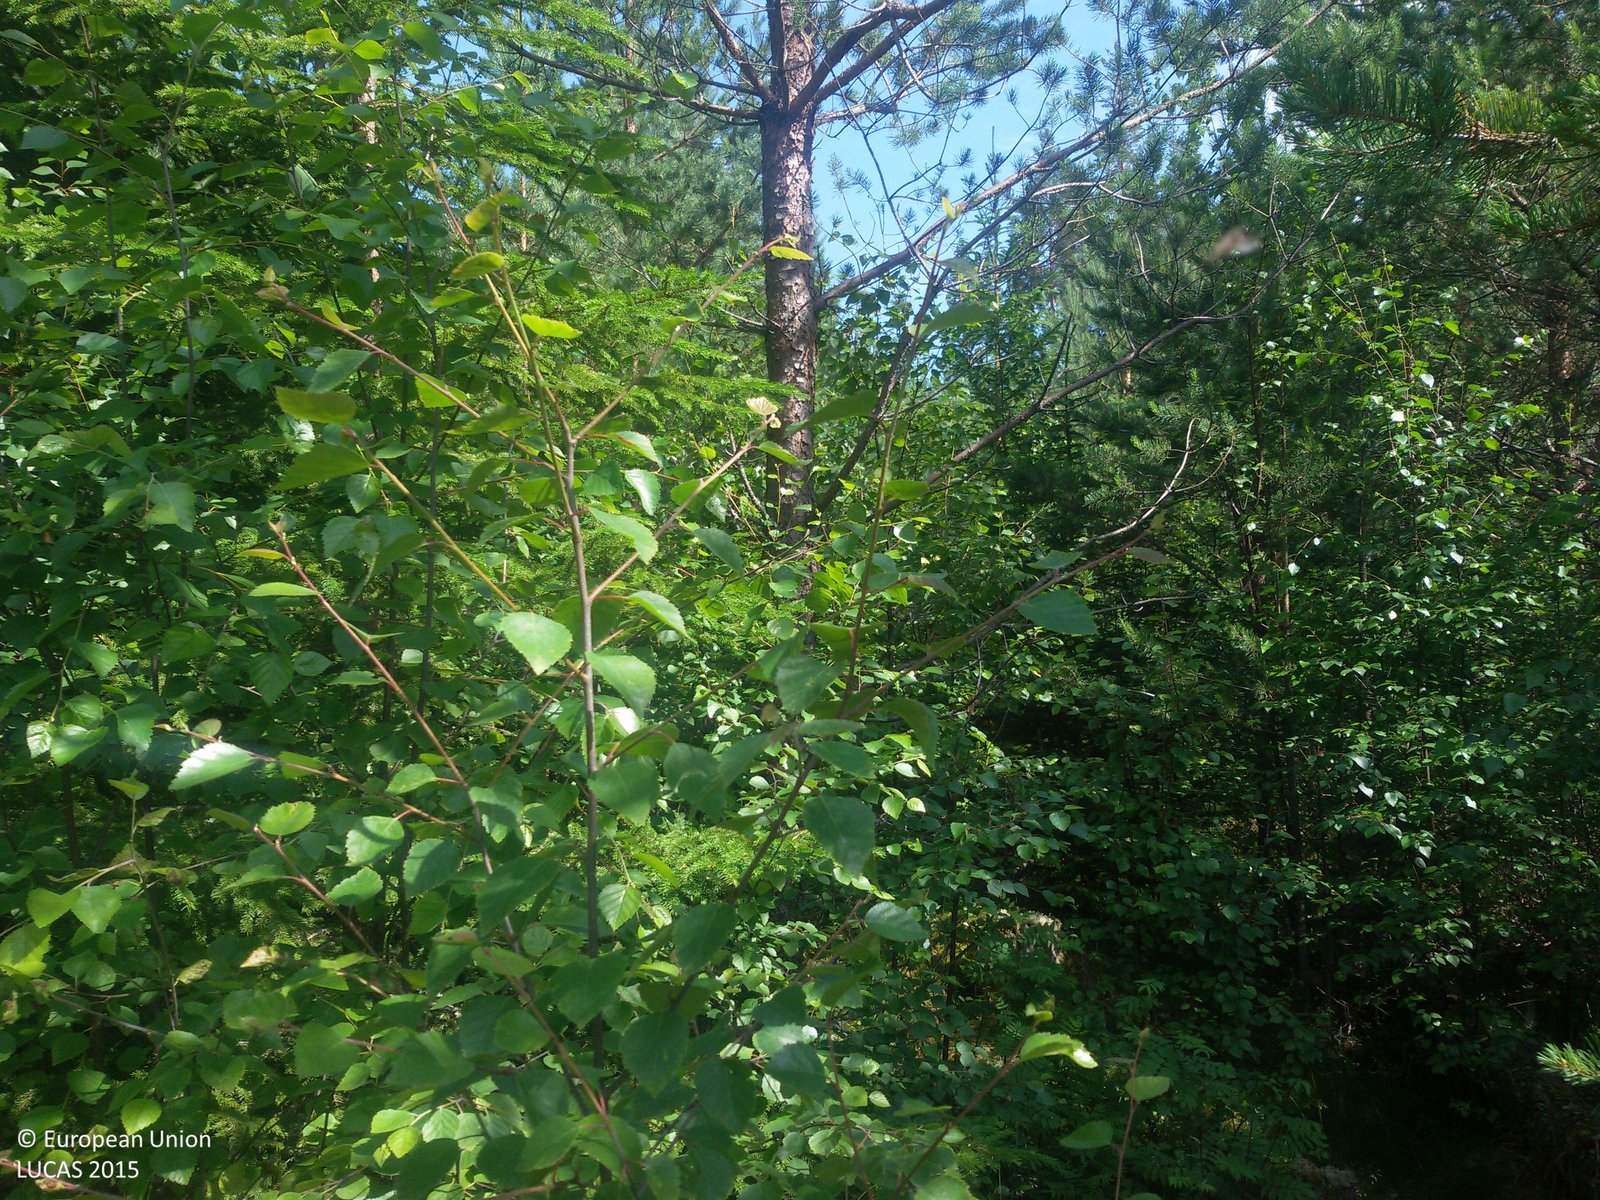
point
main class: Woodland
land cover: Pine dominated mixed woodland
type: boreal forest
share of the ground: > 75 %
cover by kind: coniferous forest trees 70 %, broadleaved forest trees 30 %
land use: Forestry
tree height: < 5 m
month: July
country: SE
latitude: 60.4726
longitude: 14.9538
